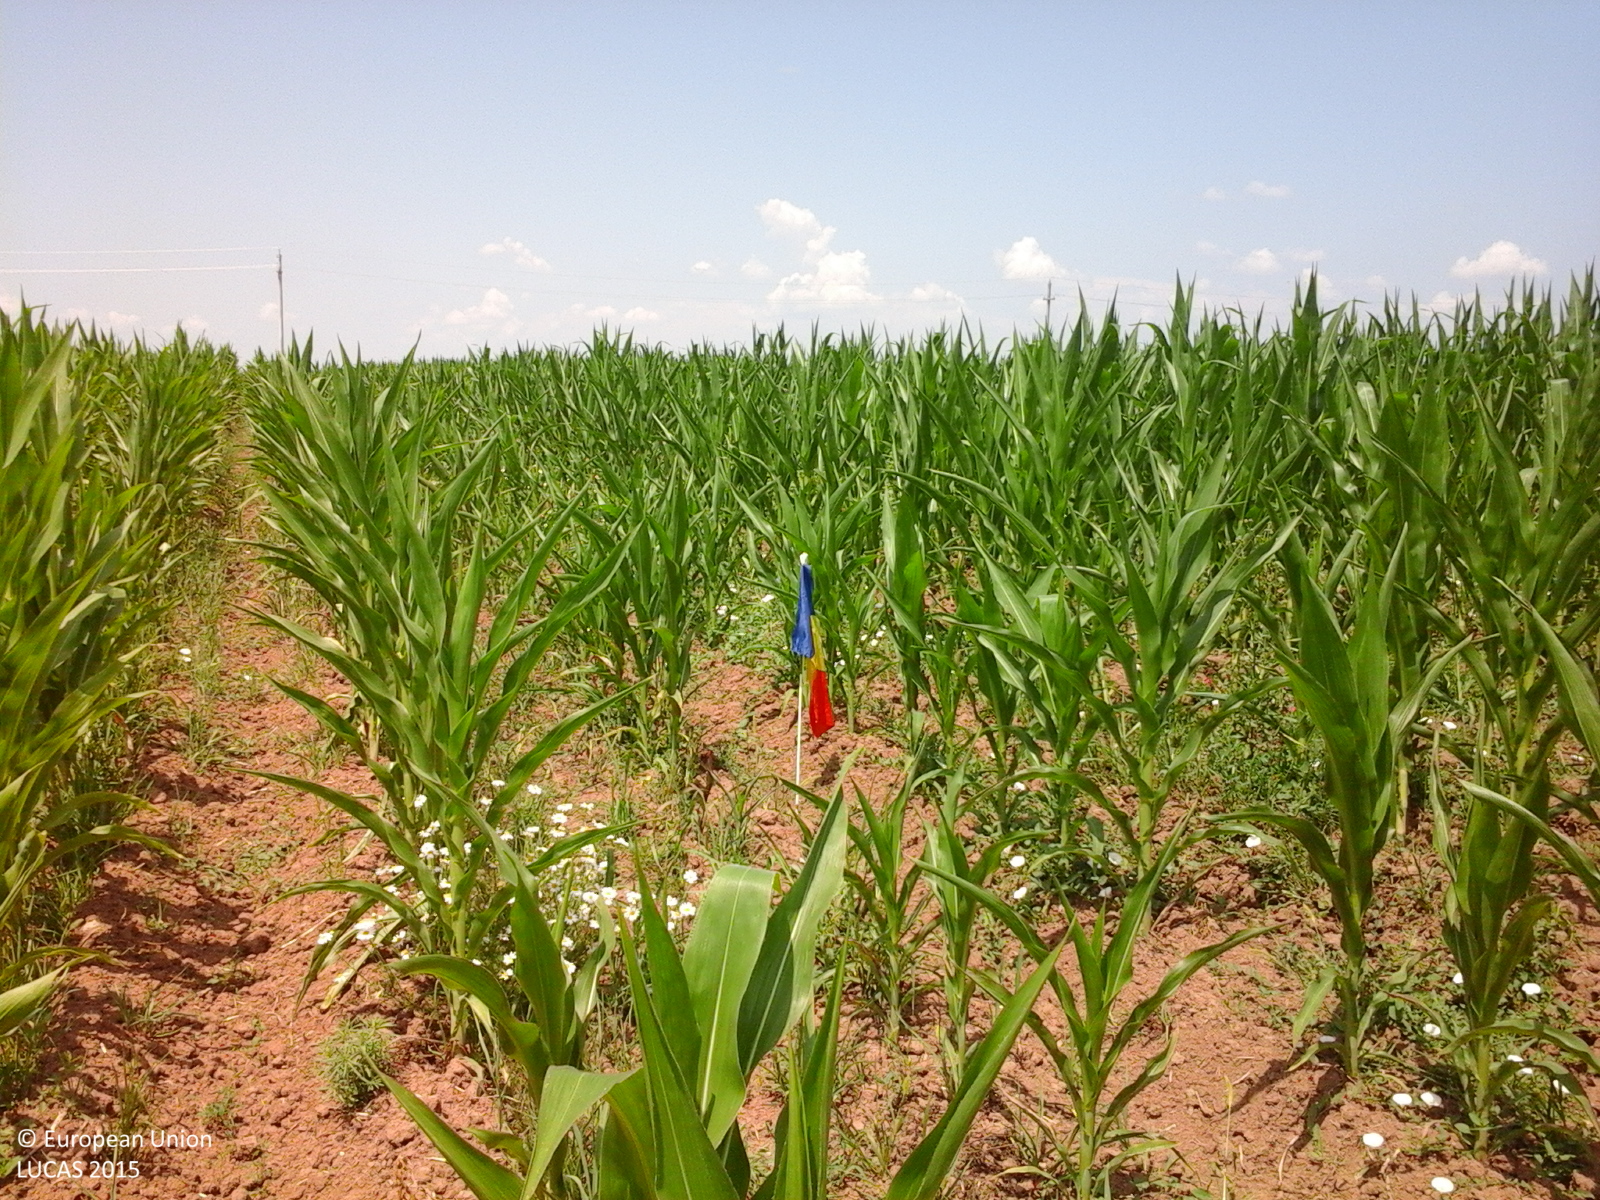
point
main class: Cropland
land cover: Maize
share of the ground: > 75 %
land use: Agriculture (excluding fallow land and kitchen gardens)
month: July
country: RO
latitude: 44.3651
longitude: 25.7691
